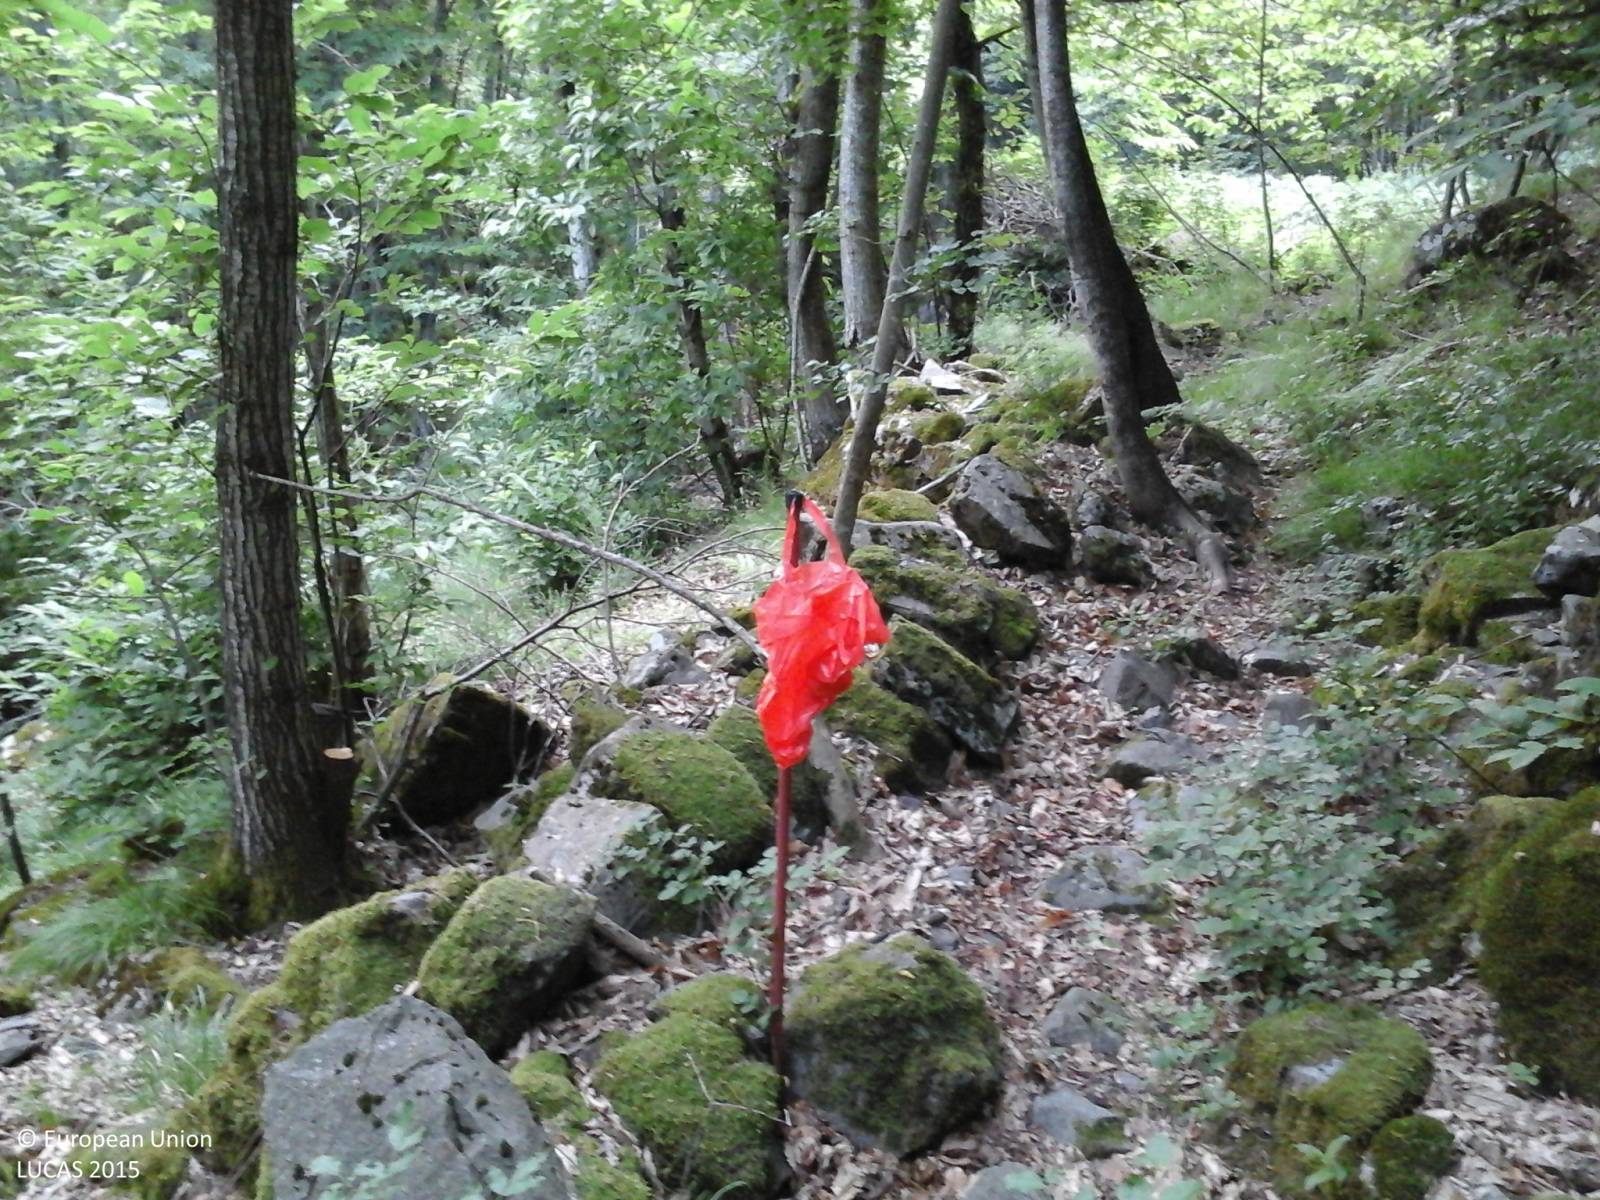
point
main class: Woodland
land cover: Broadleaved woodland
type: thermophilous deciduous forest
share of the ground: > 75 %
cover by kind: broadleaved forest trees 75 %, shrubs 25 %
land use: Forestry
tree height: > 5 m
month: June
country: IT
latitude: 44.1317
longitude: 10.7107
